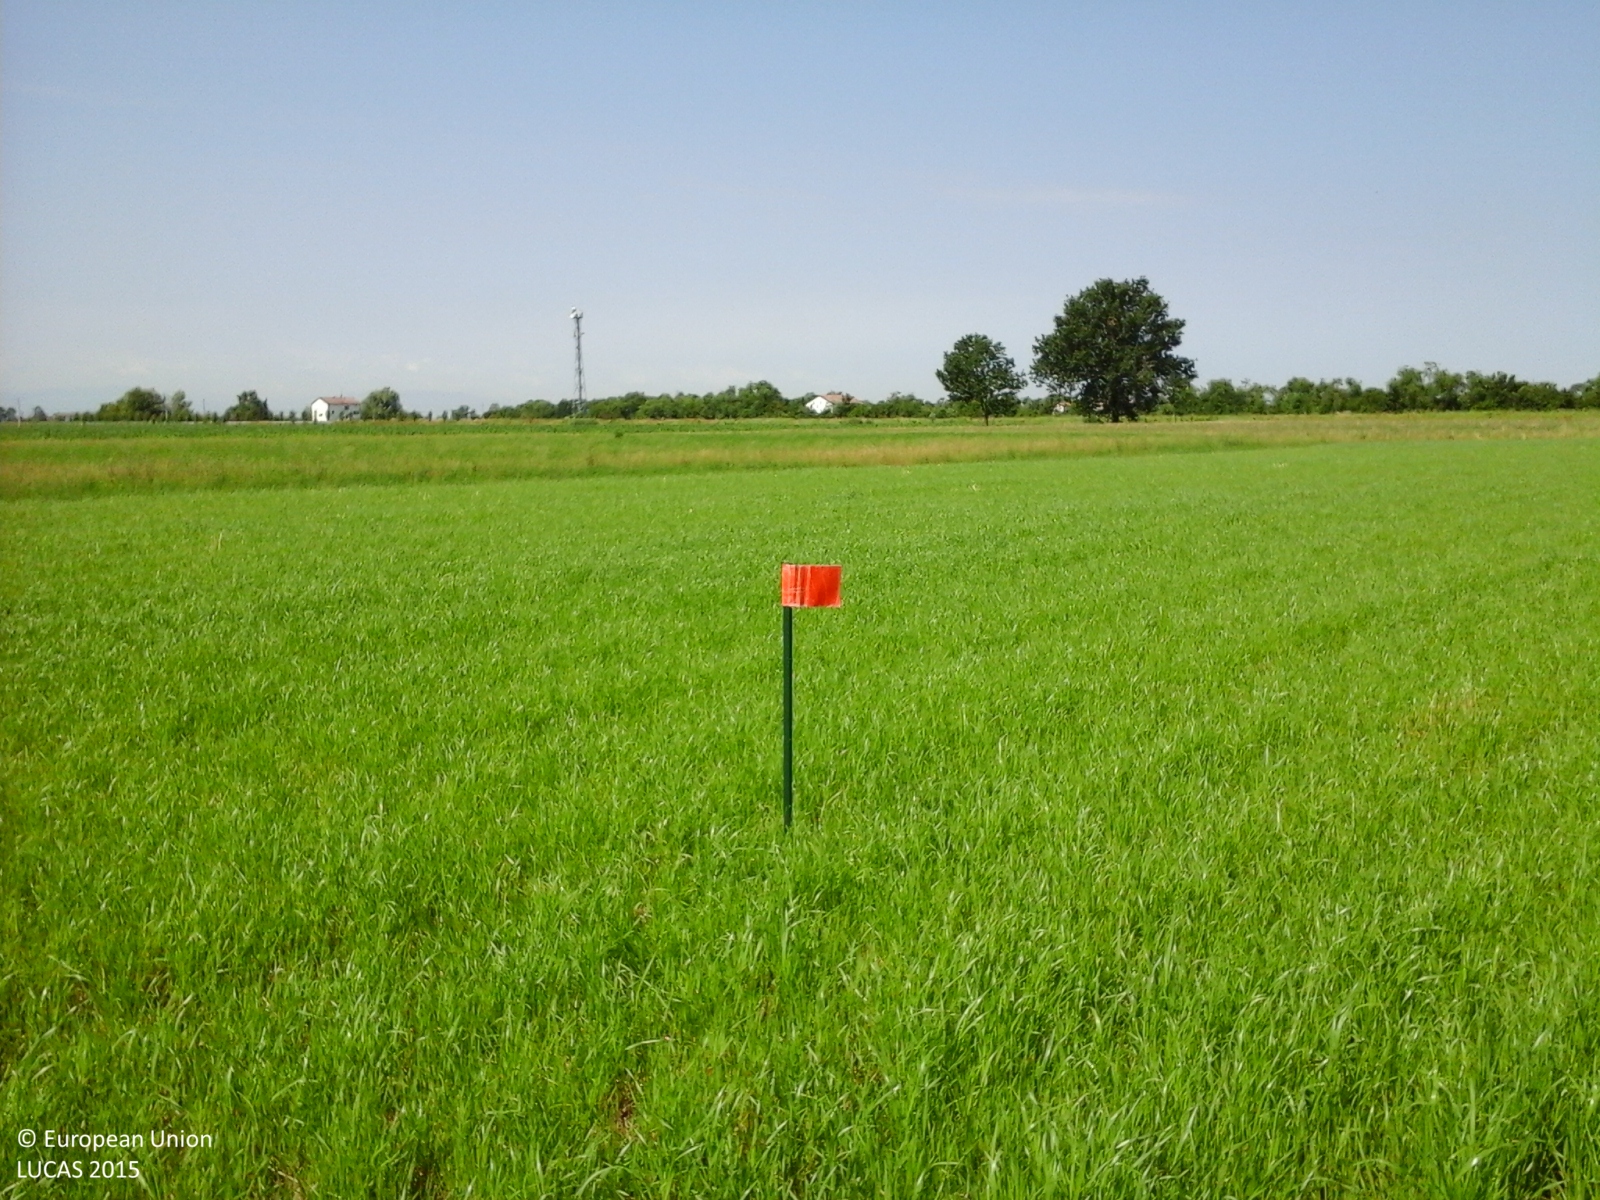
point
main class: Cropland
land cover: Temporary grasslands
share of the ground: > 75 %
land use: Agriculture (excluding fallow land and kitchen gardens)
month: May
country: IT
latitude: 44.8171
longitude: 10.6941
